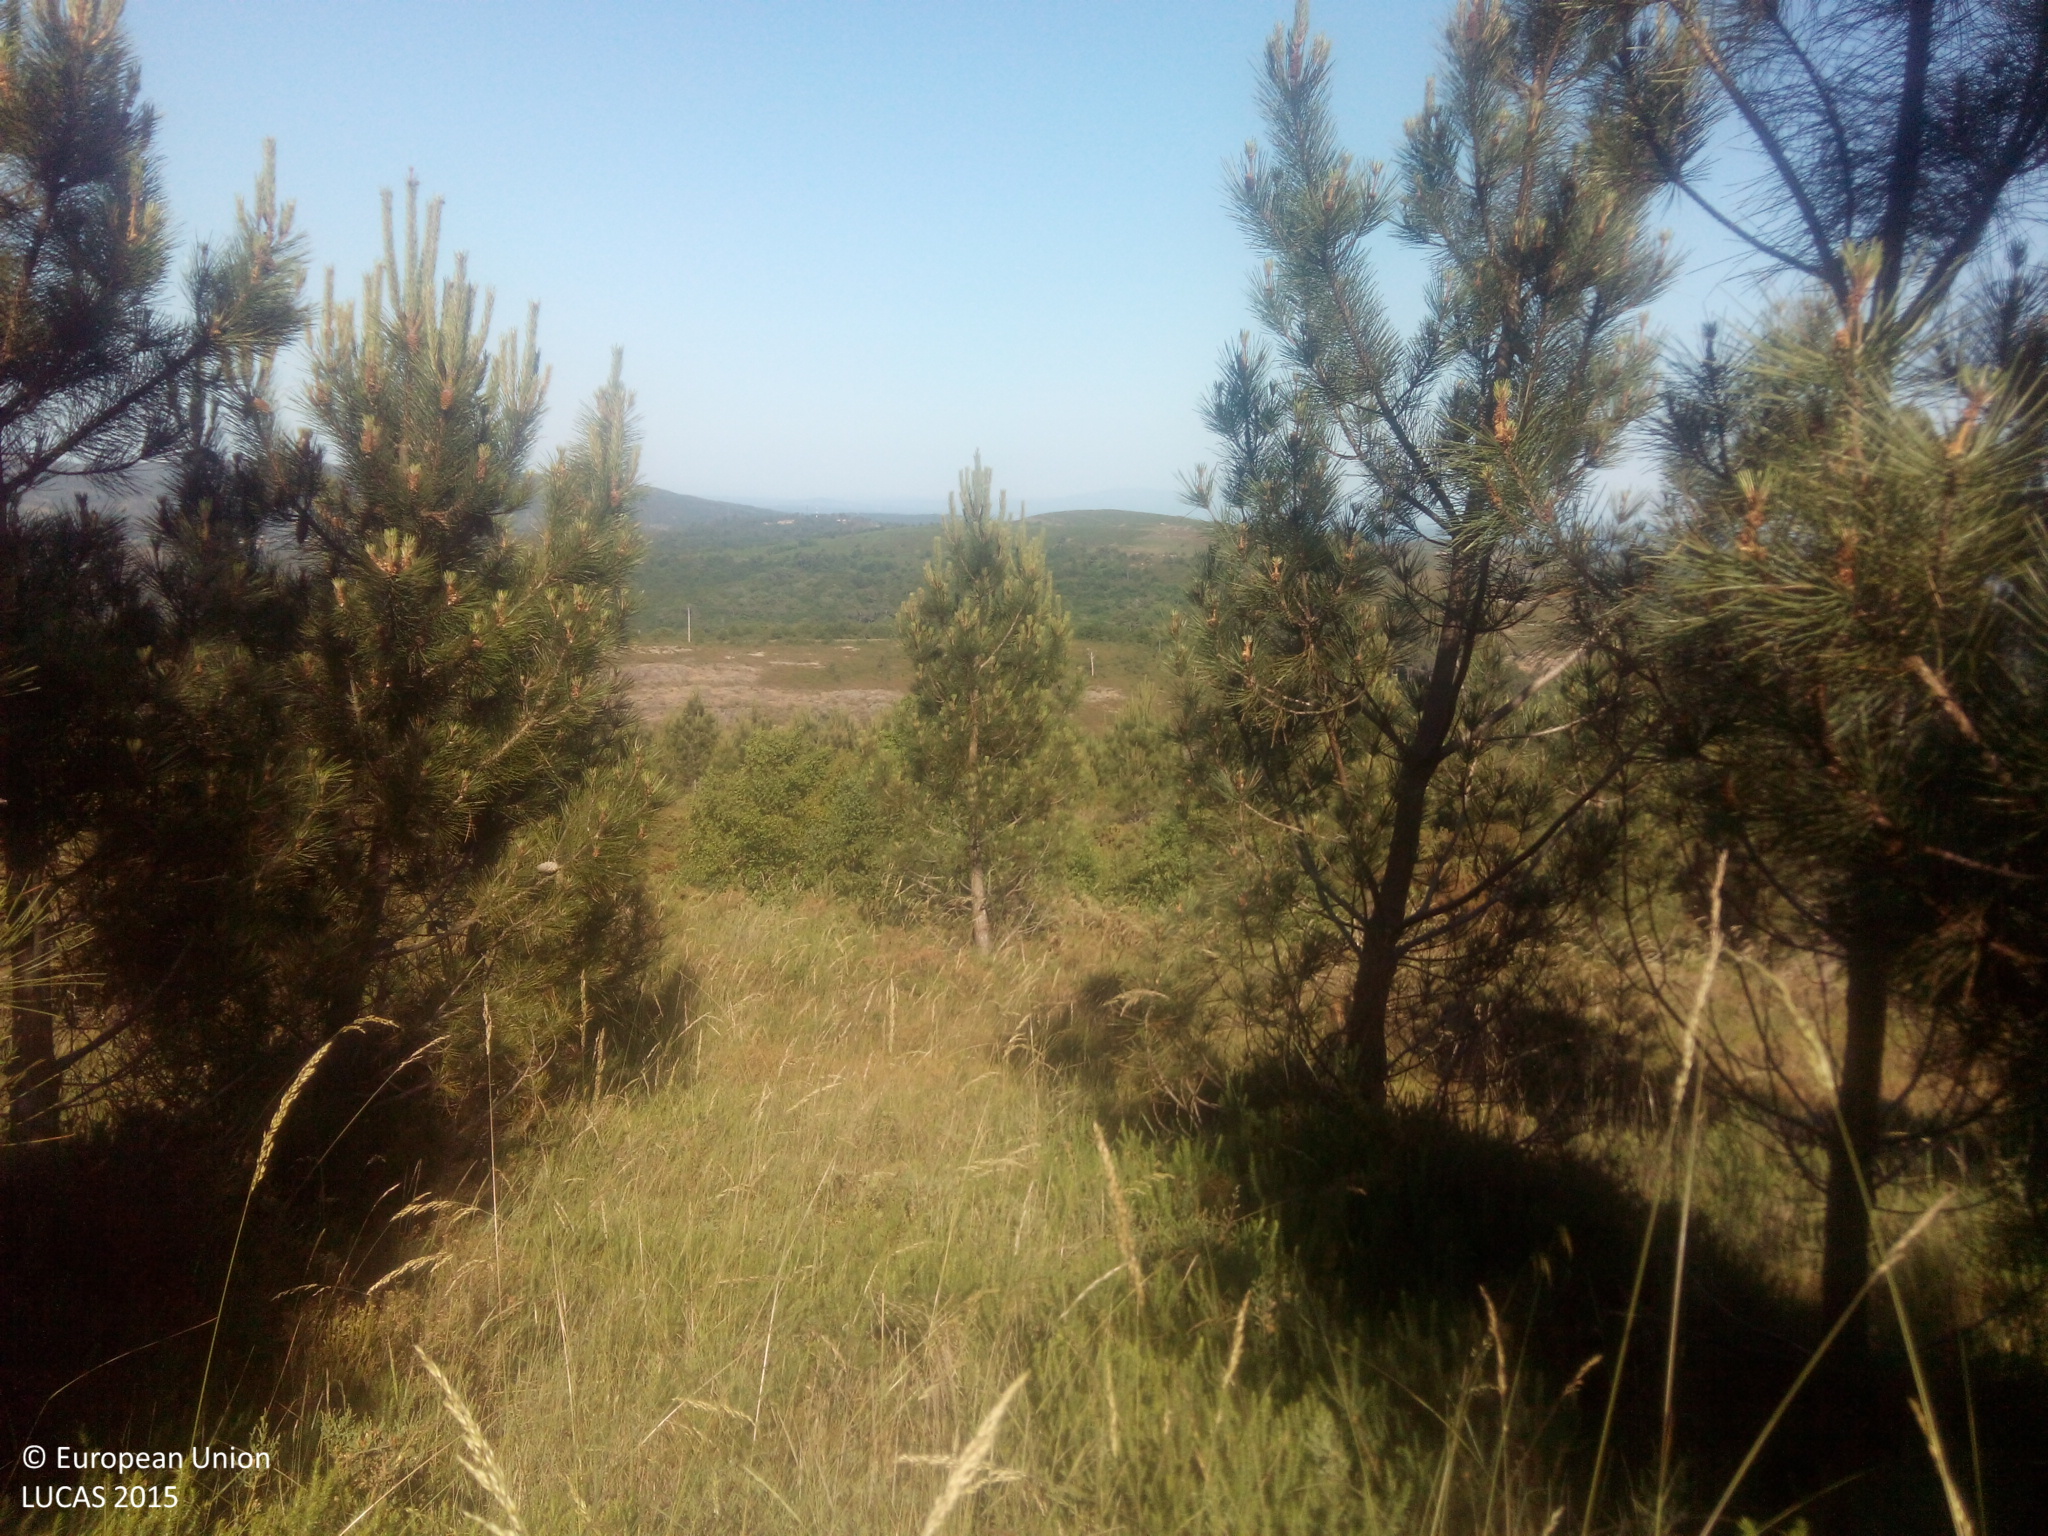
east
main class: Woodland
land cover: Pine dominated coniferous woodland
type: hemiboreal forest and nemoral coniferous forest and mixed broadleaved-coniferous forest
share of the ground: > 75 %
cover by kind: coniferous forest trees 100 %
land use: Forestry
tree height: < 5 m
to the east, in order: Pine dominated coniferous woodland; Grassland with sparse tree/shrub cover; Tracks; Pine dominated coniferous woodland; Rivers and streams; Shrubland with sparse tree cover; Pine dominated coniferous woodland; Rivers and streams; Shrubland with sparse tree cover; Pine dominated coniferous woodland; Rivers and streams; Shrubland with sparse tree cover; Pine dominated coniferous woodland; Tracks; Shrubland without tree cover; Tracks; Pine dominated coniferous woodland
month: June
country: ES
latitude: 42.4444
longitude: -8.3163
